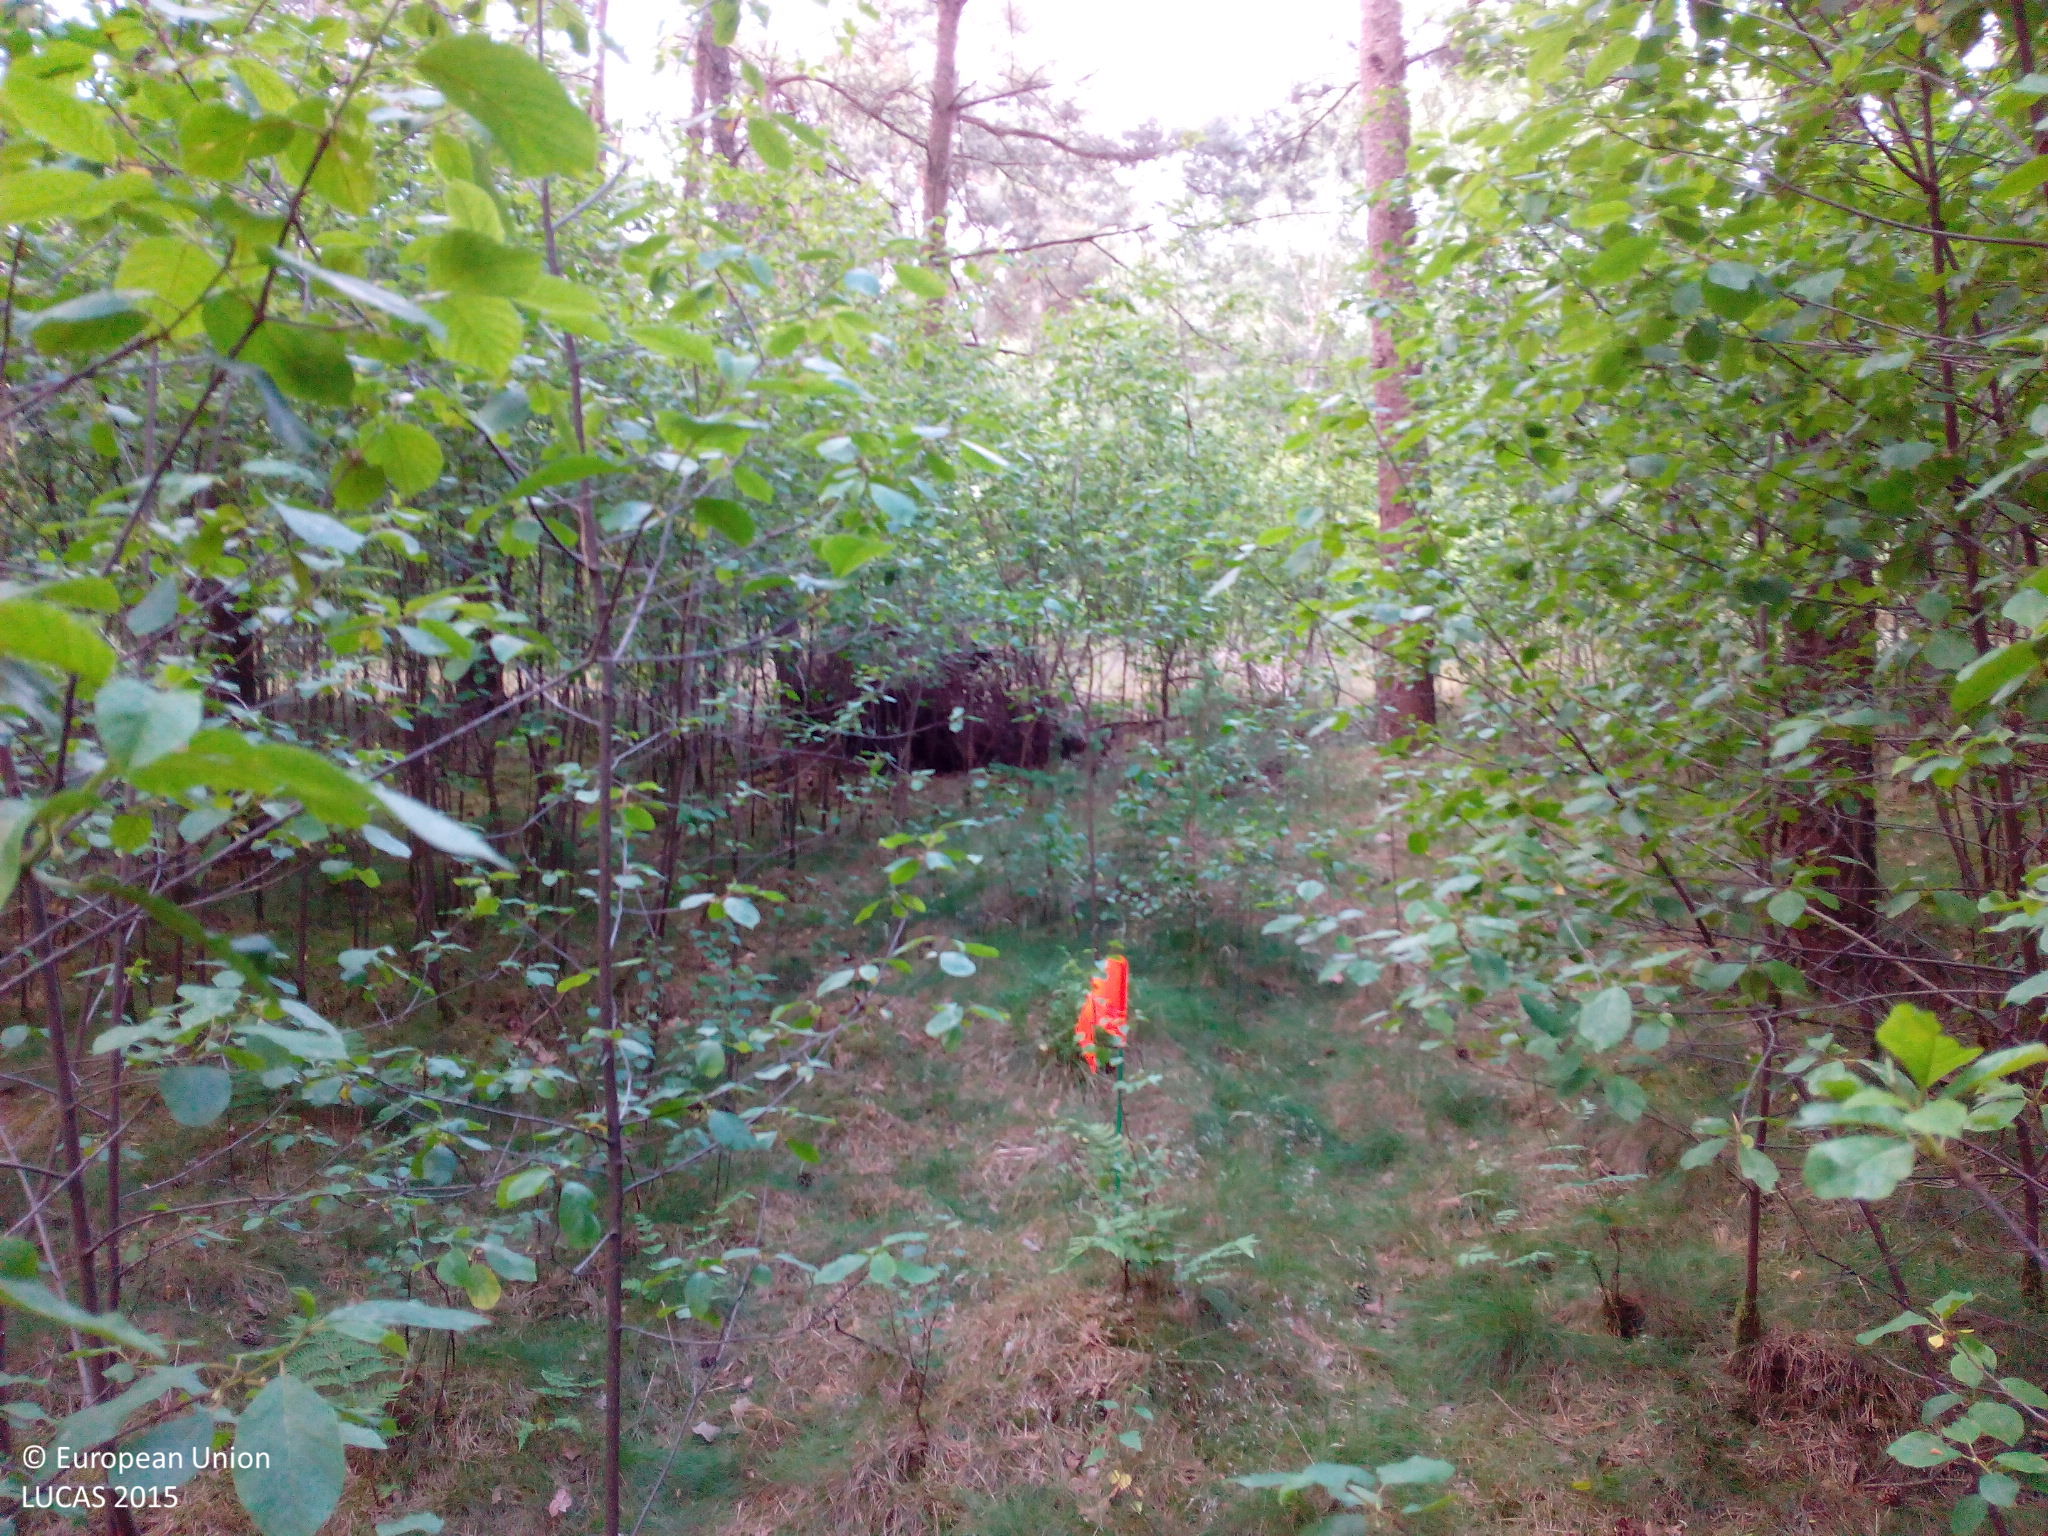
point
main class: Woodland
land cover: Pine dominated coniferous woodland
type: hemiboreal forest and nemoral coniferous forest and mixed broadleaved-coniferous forest
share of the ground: 50 - 75 %
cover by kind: coniferous forest trees 70 %, shrubs 15 %, herbaceous plants 10 %, broadleaved forest trees 5 %
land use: Forestry
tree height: > 5 m
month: June
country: DE
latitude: 52.6371
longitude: 7.4145
